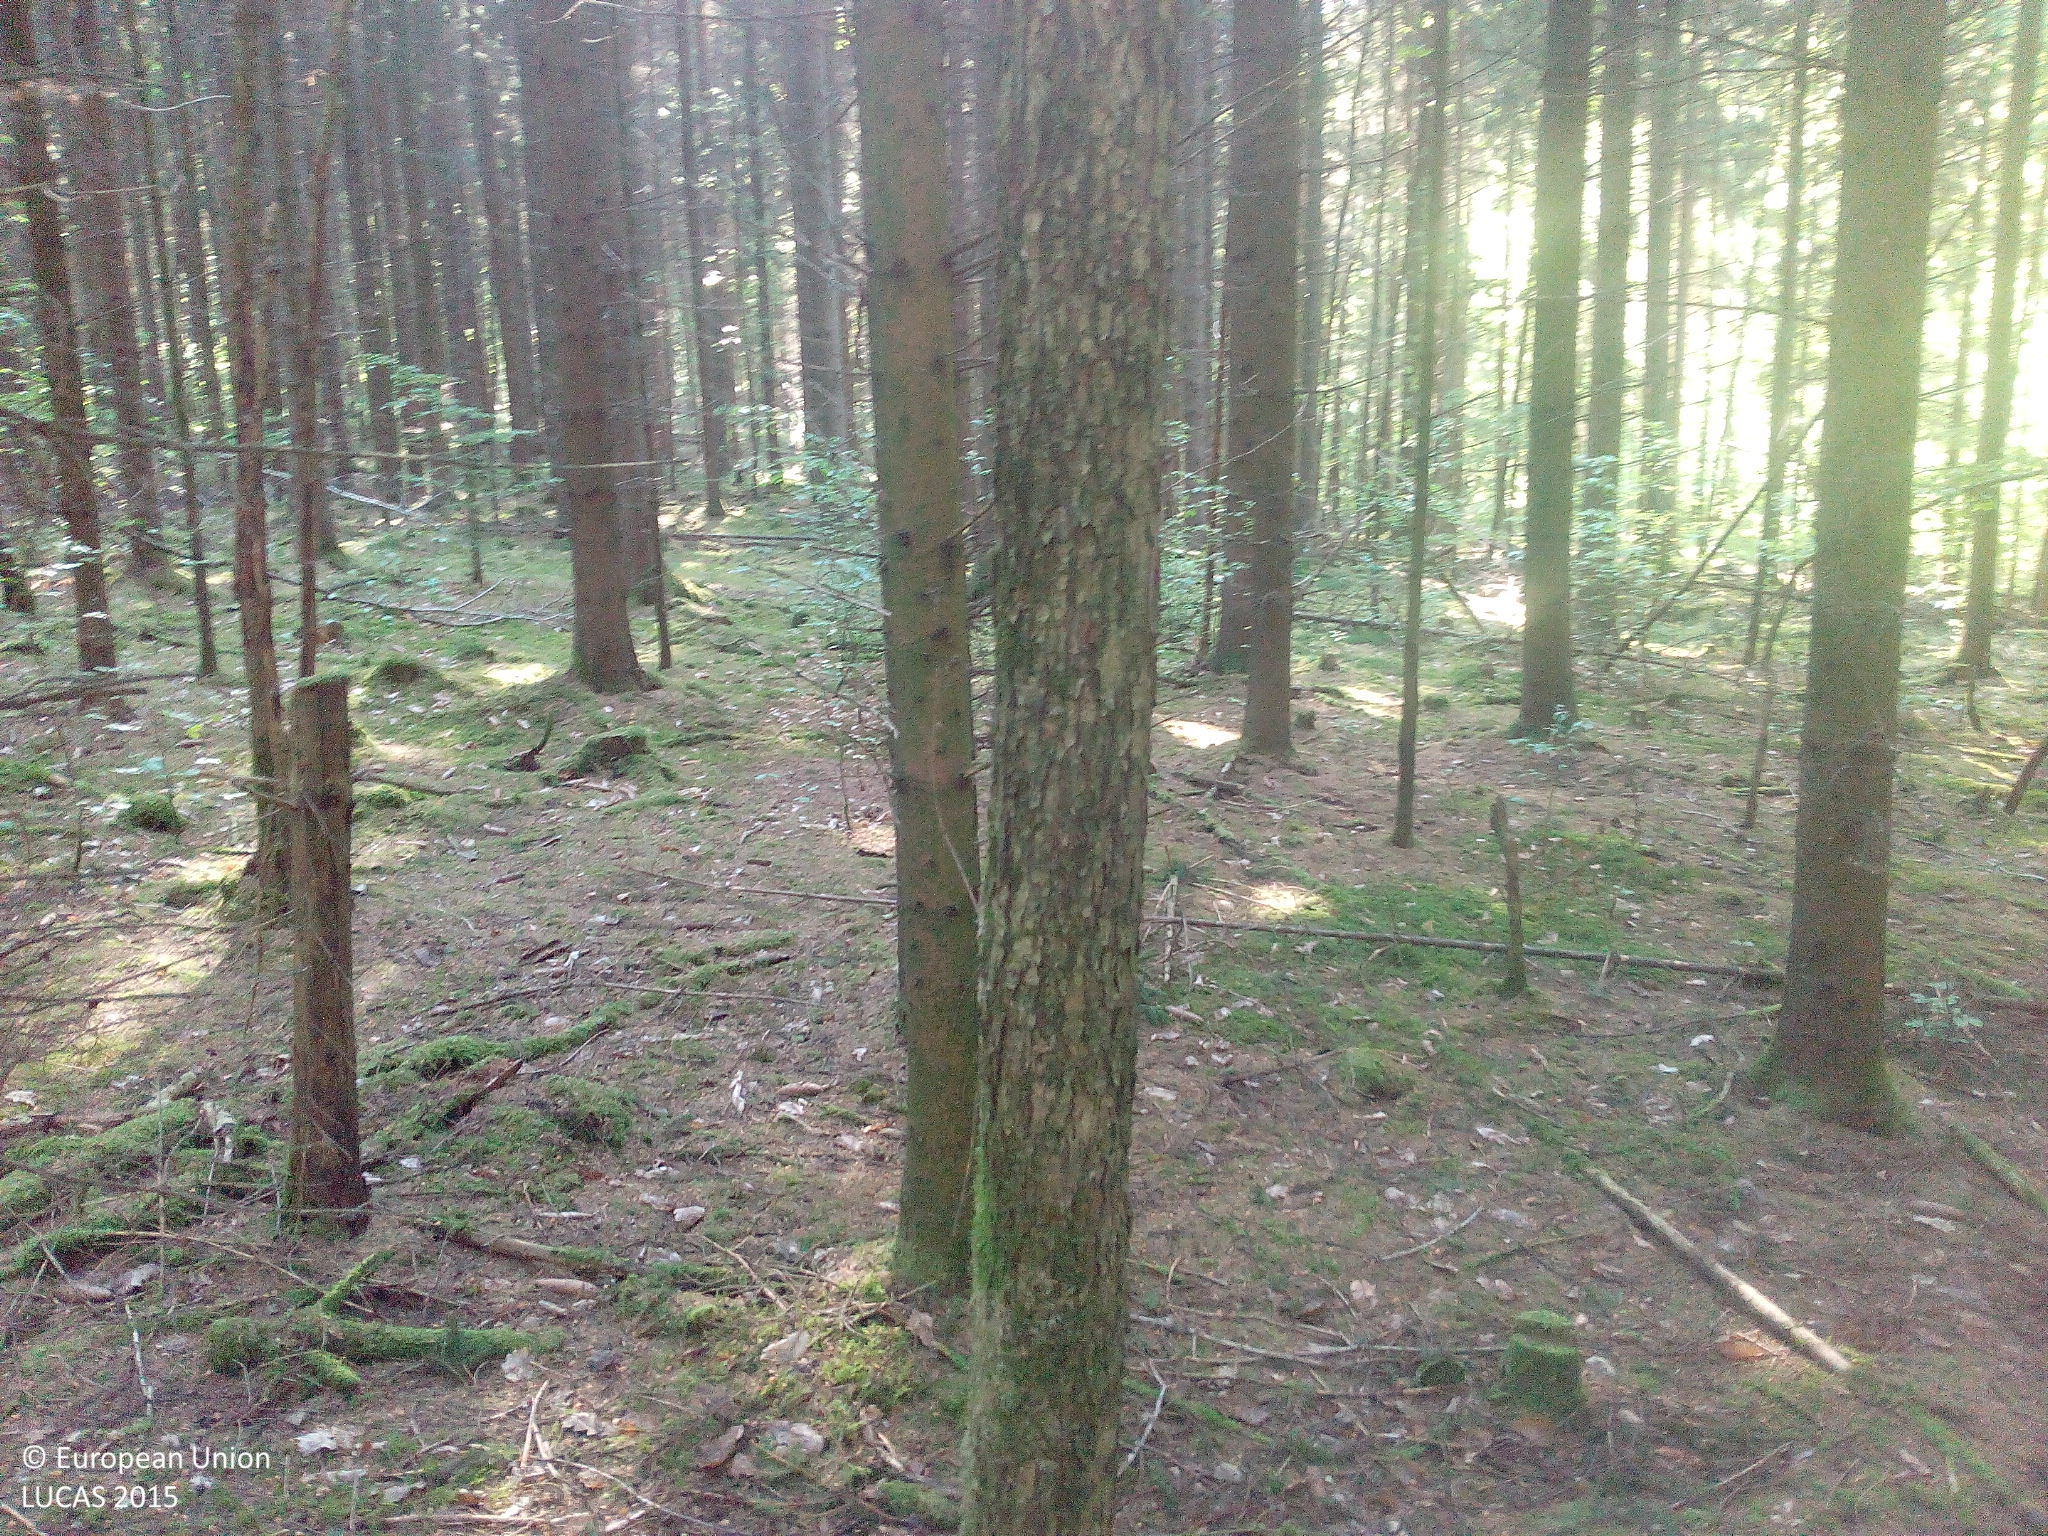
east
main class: Woodland
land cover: Spruce dominated coniferous woodland
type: hemiboreal forest and nemoral coniferous forest and mixed broadleaved-coniferous forest
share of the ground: > 75 %
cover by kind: coniferous forest trees 100 %
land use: Forestry
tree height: > 5 m
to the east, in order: Spruce dominated coniferous woodland; Fences; Spruce dominated coniferous woodland; Tracks; Broadleaved woodland; Spruce dominated coniferous woodland; Broadleaved woodland
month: May
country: DE
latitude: 49.9826
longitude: 10.9341
